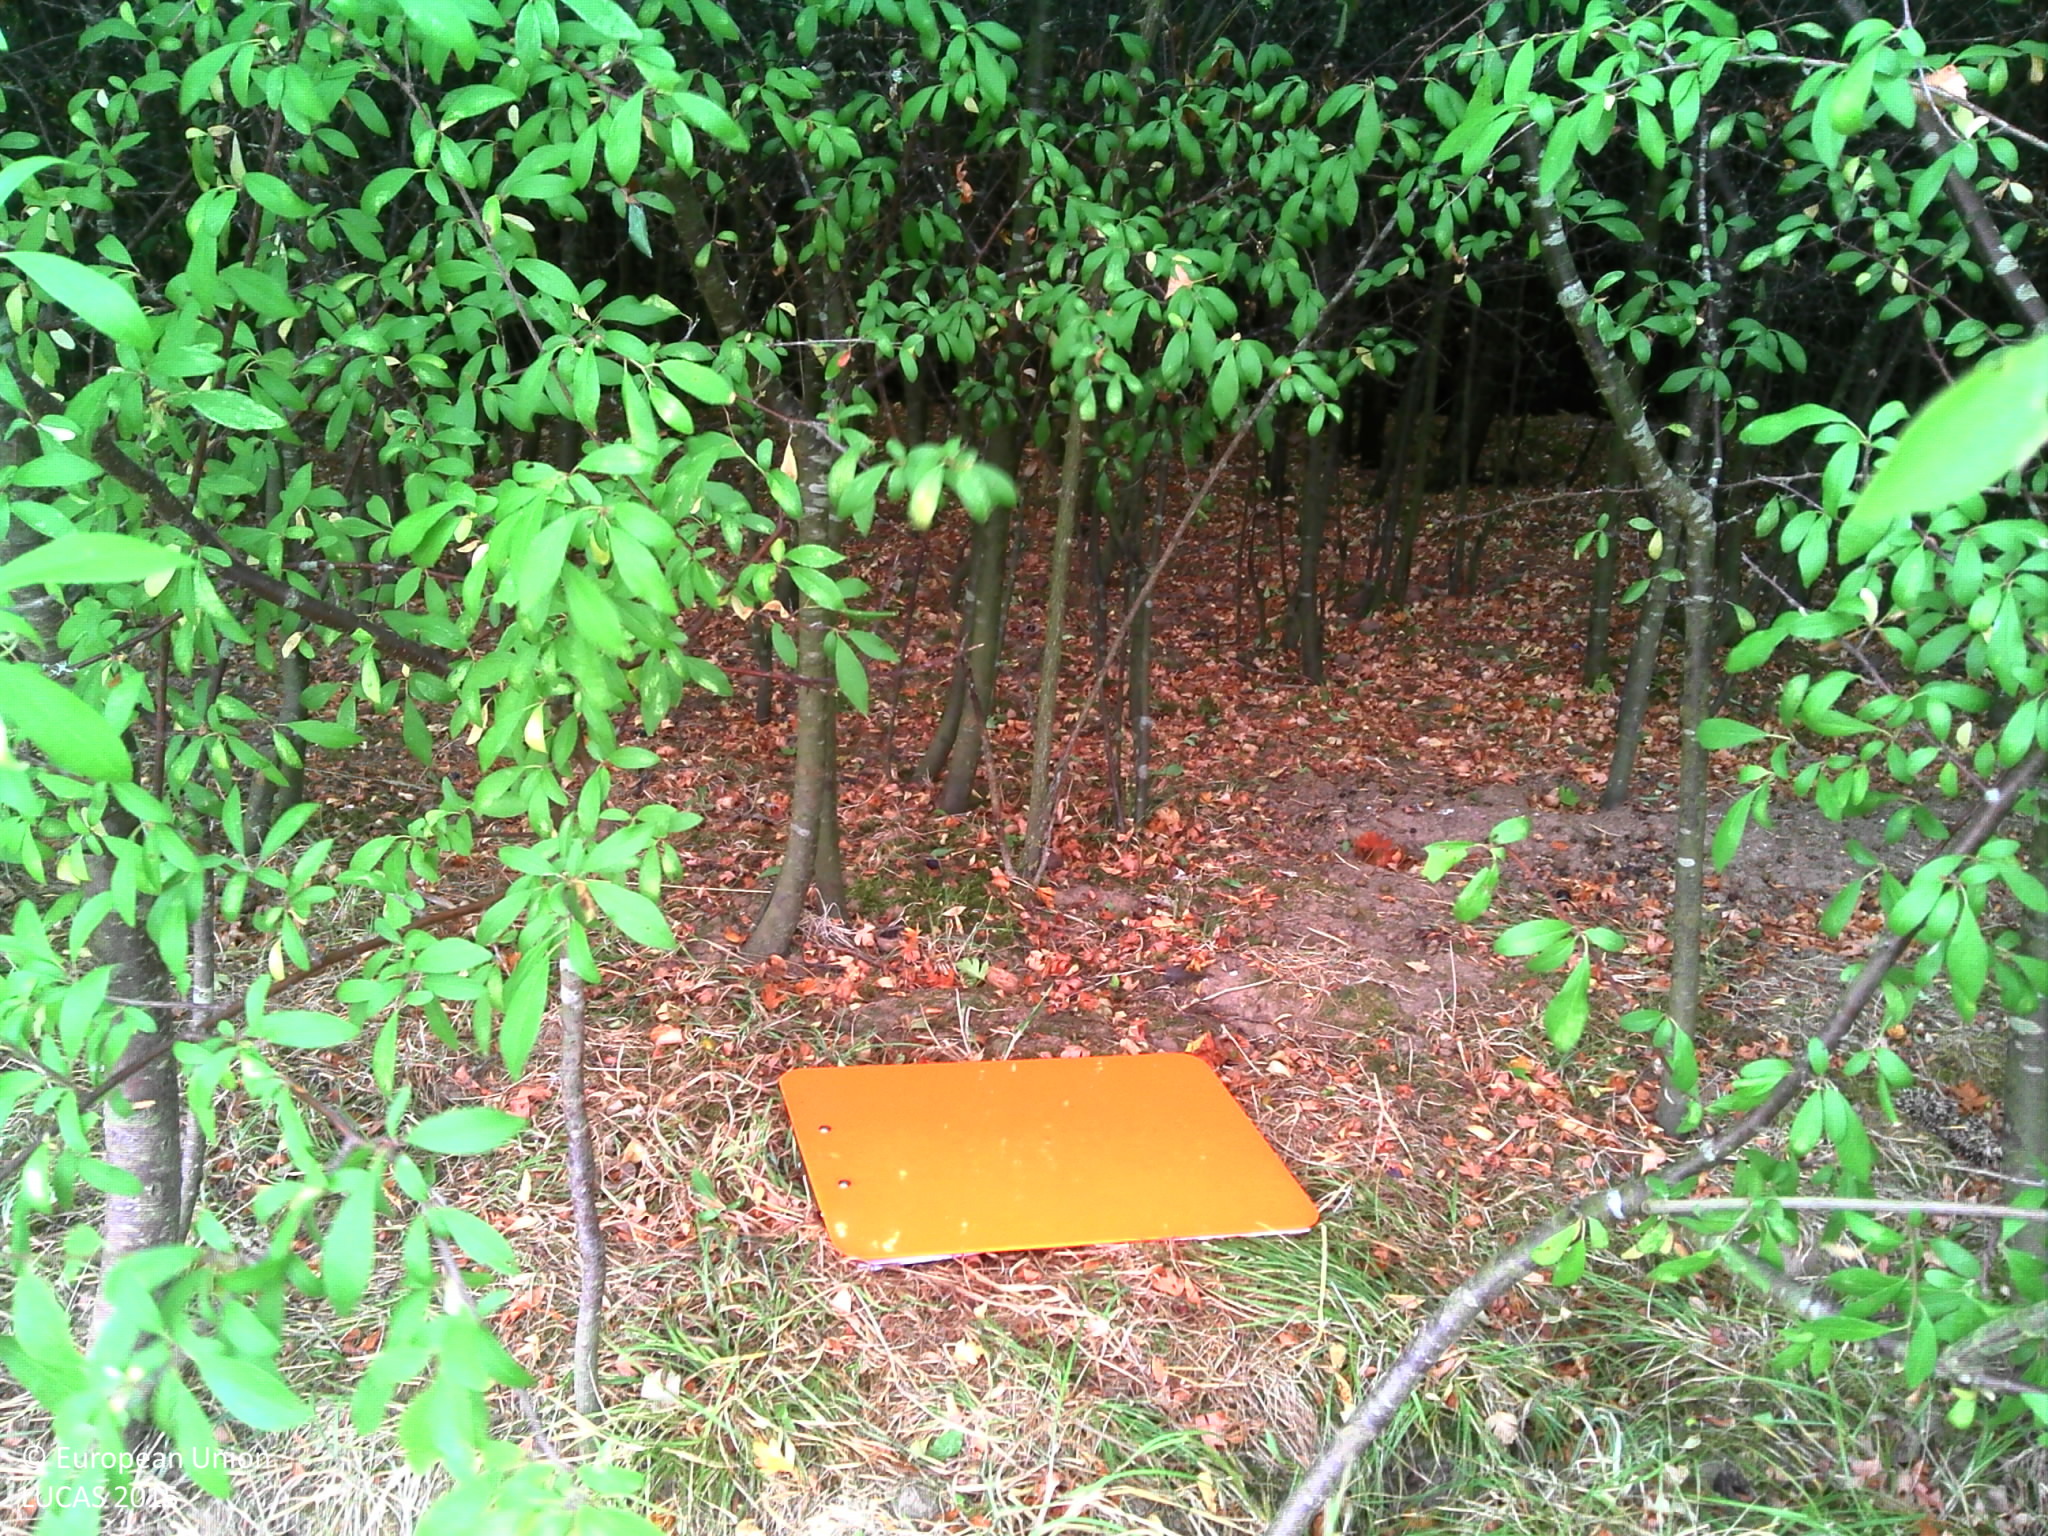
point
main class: Woodland
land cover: Broadleaved woodland
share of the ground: > 75 %
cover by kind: broadleaved forest trees 95 %, shrubs 5 %
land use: Semi-natural and natural areas not in use
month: July
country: FR
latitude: 44.4096
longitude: 0.5624
